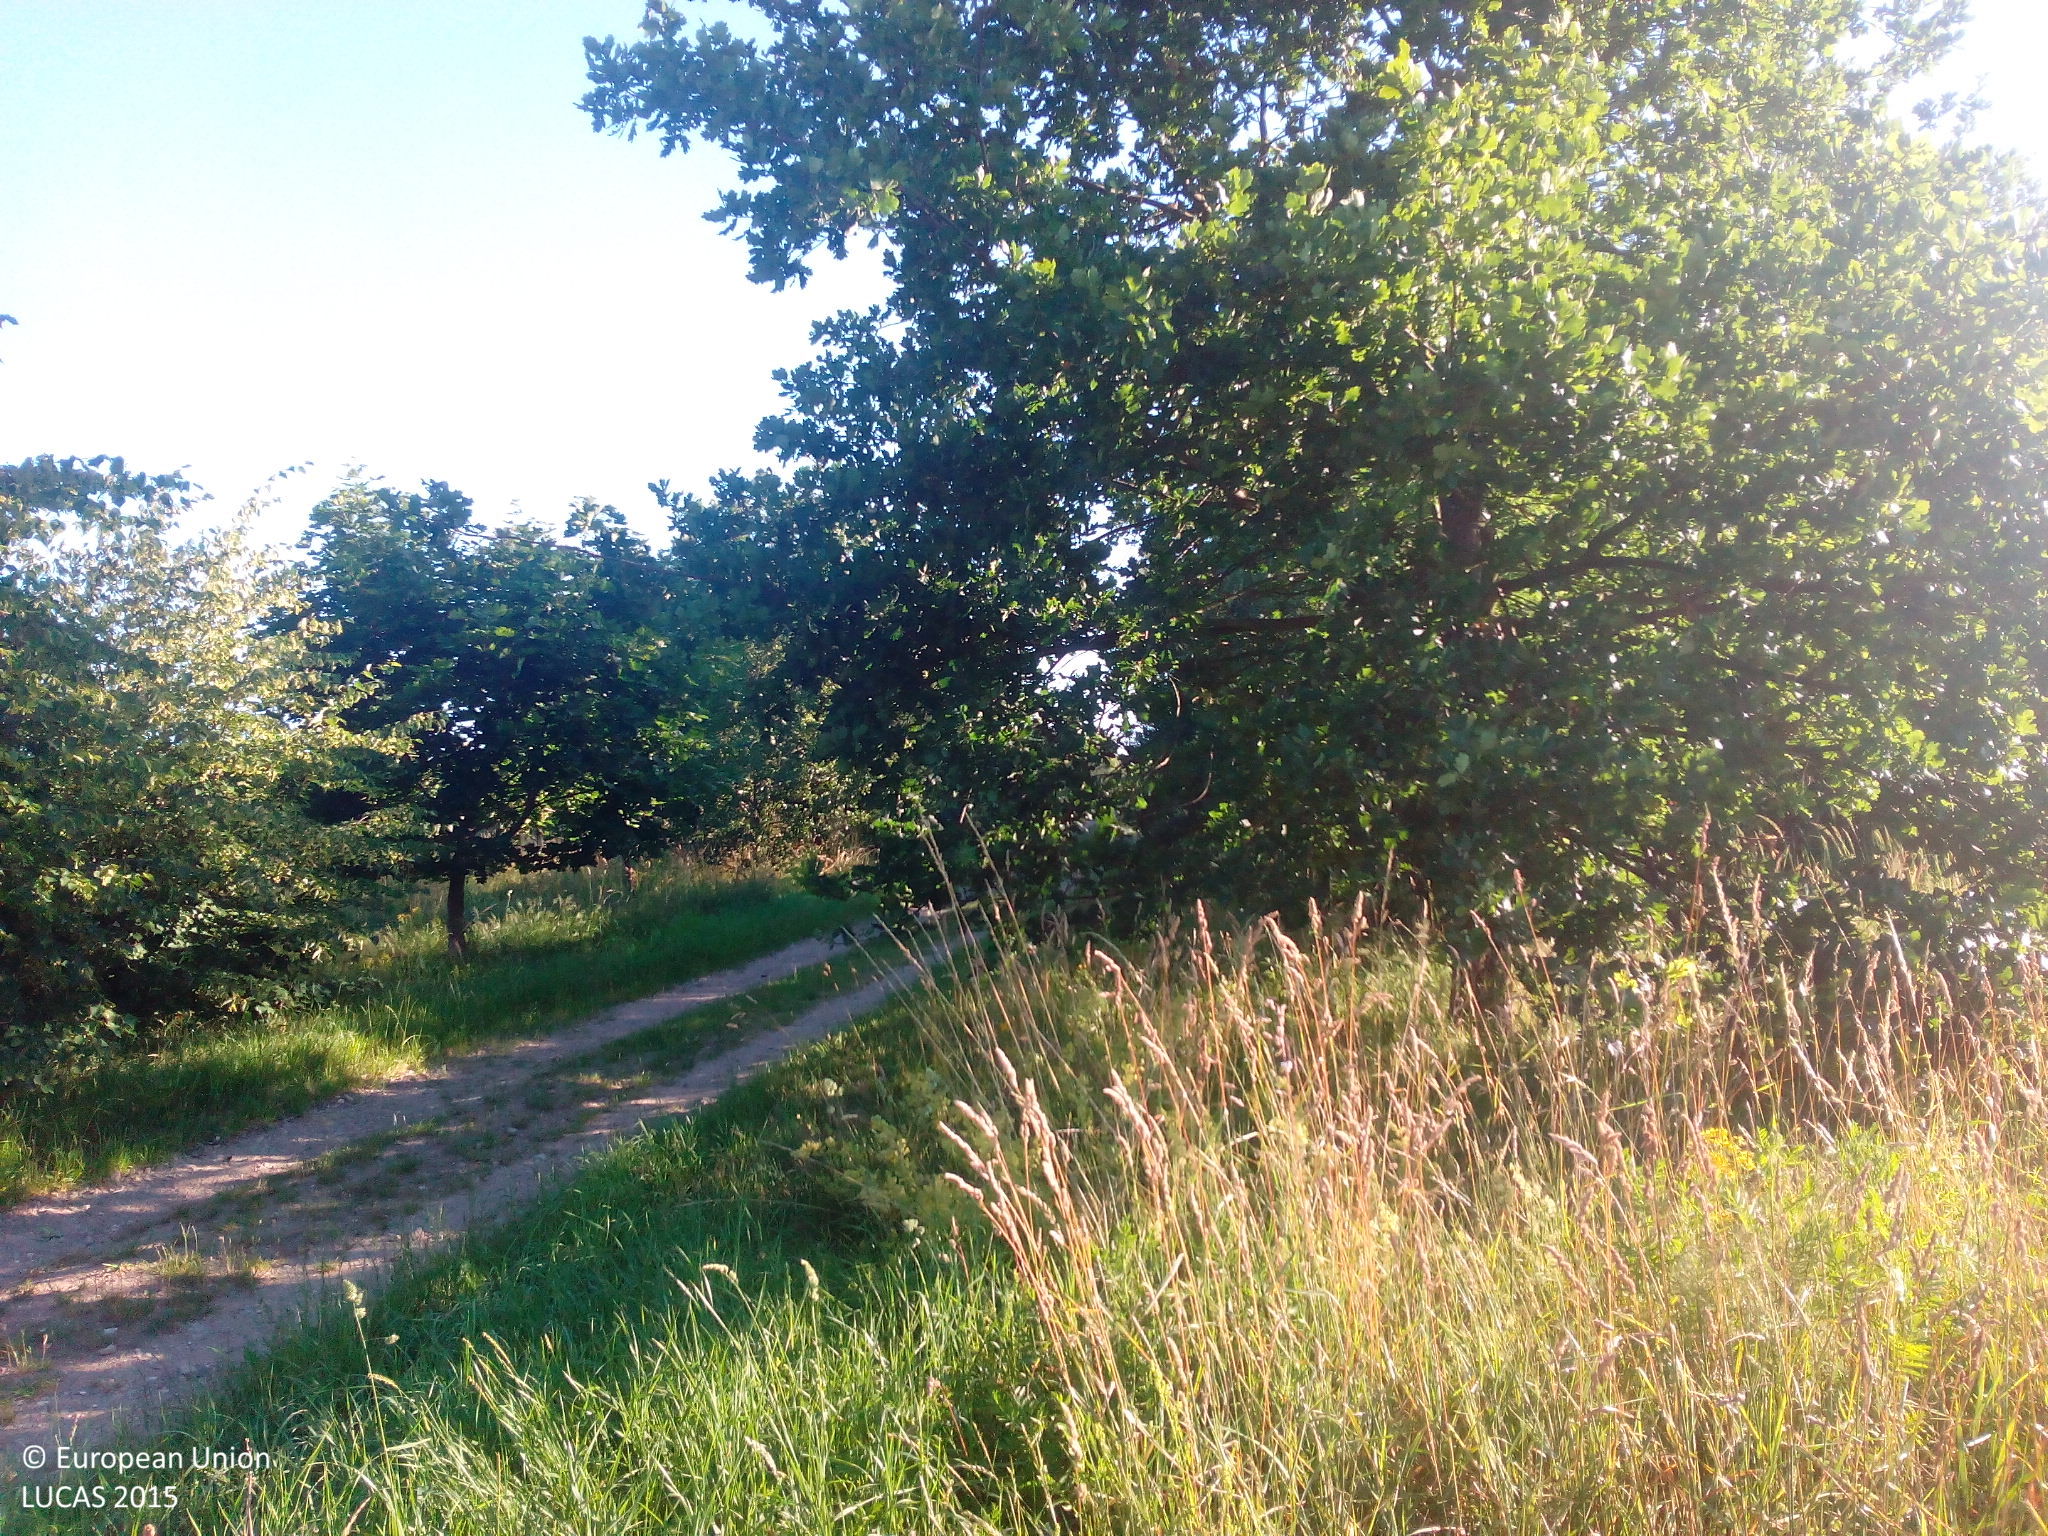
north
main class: Cropland
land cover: Rape and turnip rape
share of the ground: > 75 %
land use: Agriculture (excluding fallow land and kitchen gardens)
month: July
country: DE
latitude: 51.3652
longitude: 13.1169
